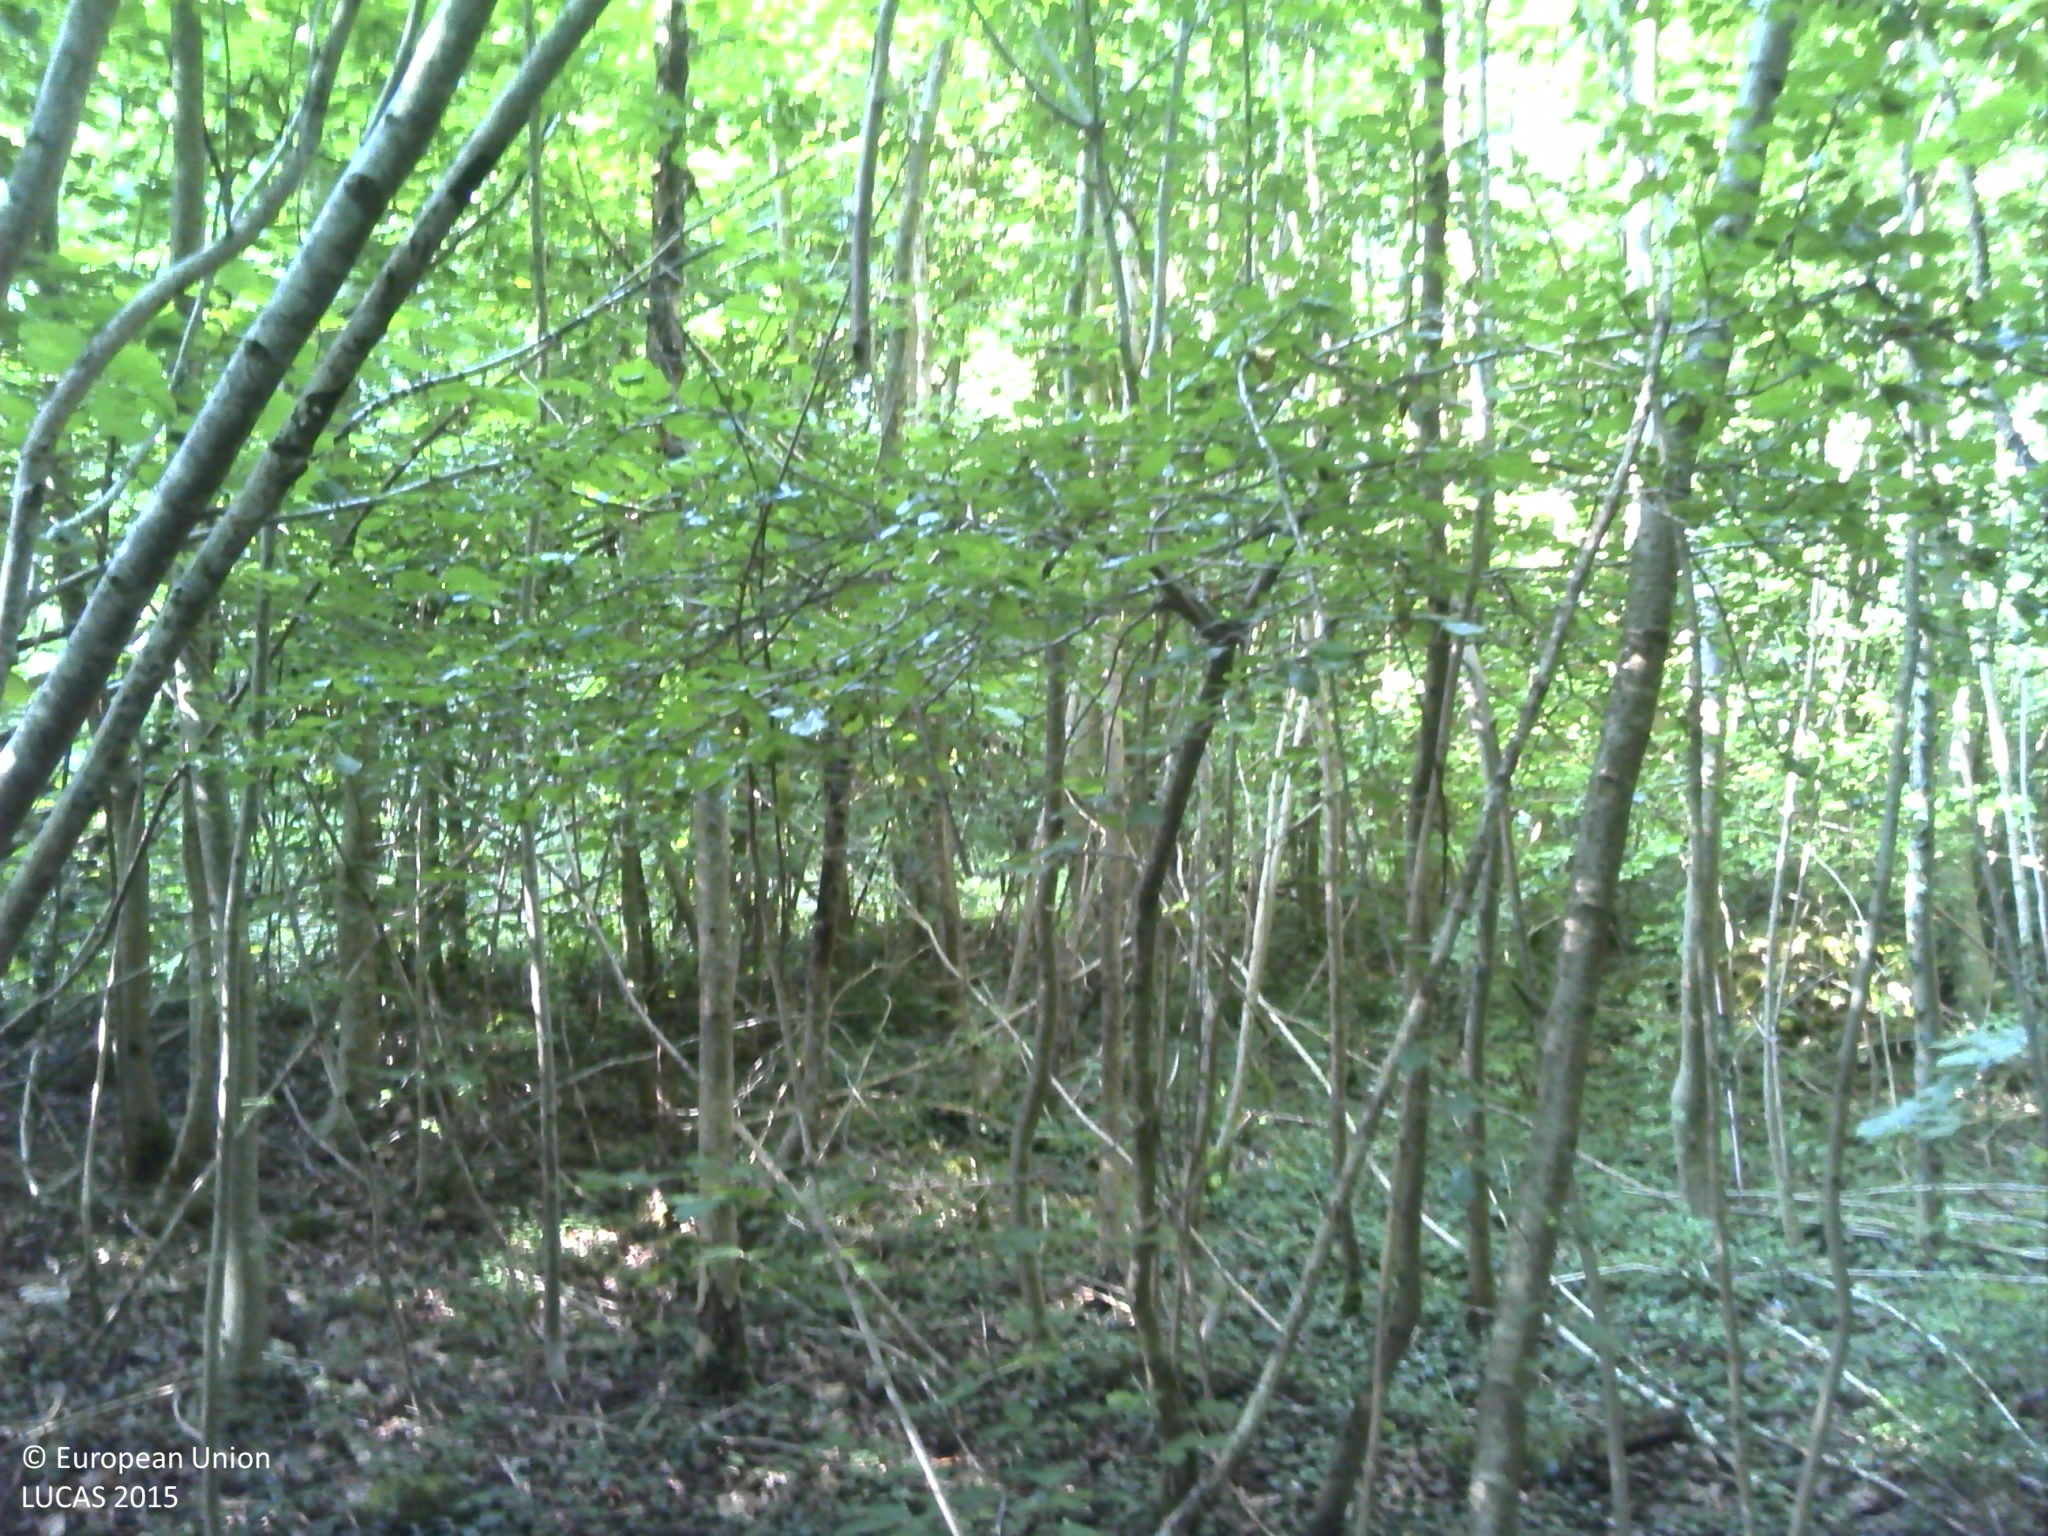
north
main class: Woodland
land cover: Broadleaved woodland
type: acidophilous oak and oak-birch forest
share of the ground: > 75 %
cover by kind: broadleaved forest trees 100 %
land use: Forestry
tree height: > 5 m
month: July
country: FR
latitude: 48.8980
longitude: 6.8220
